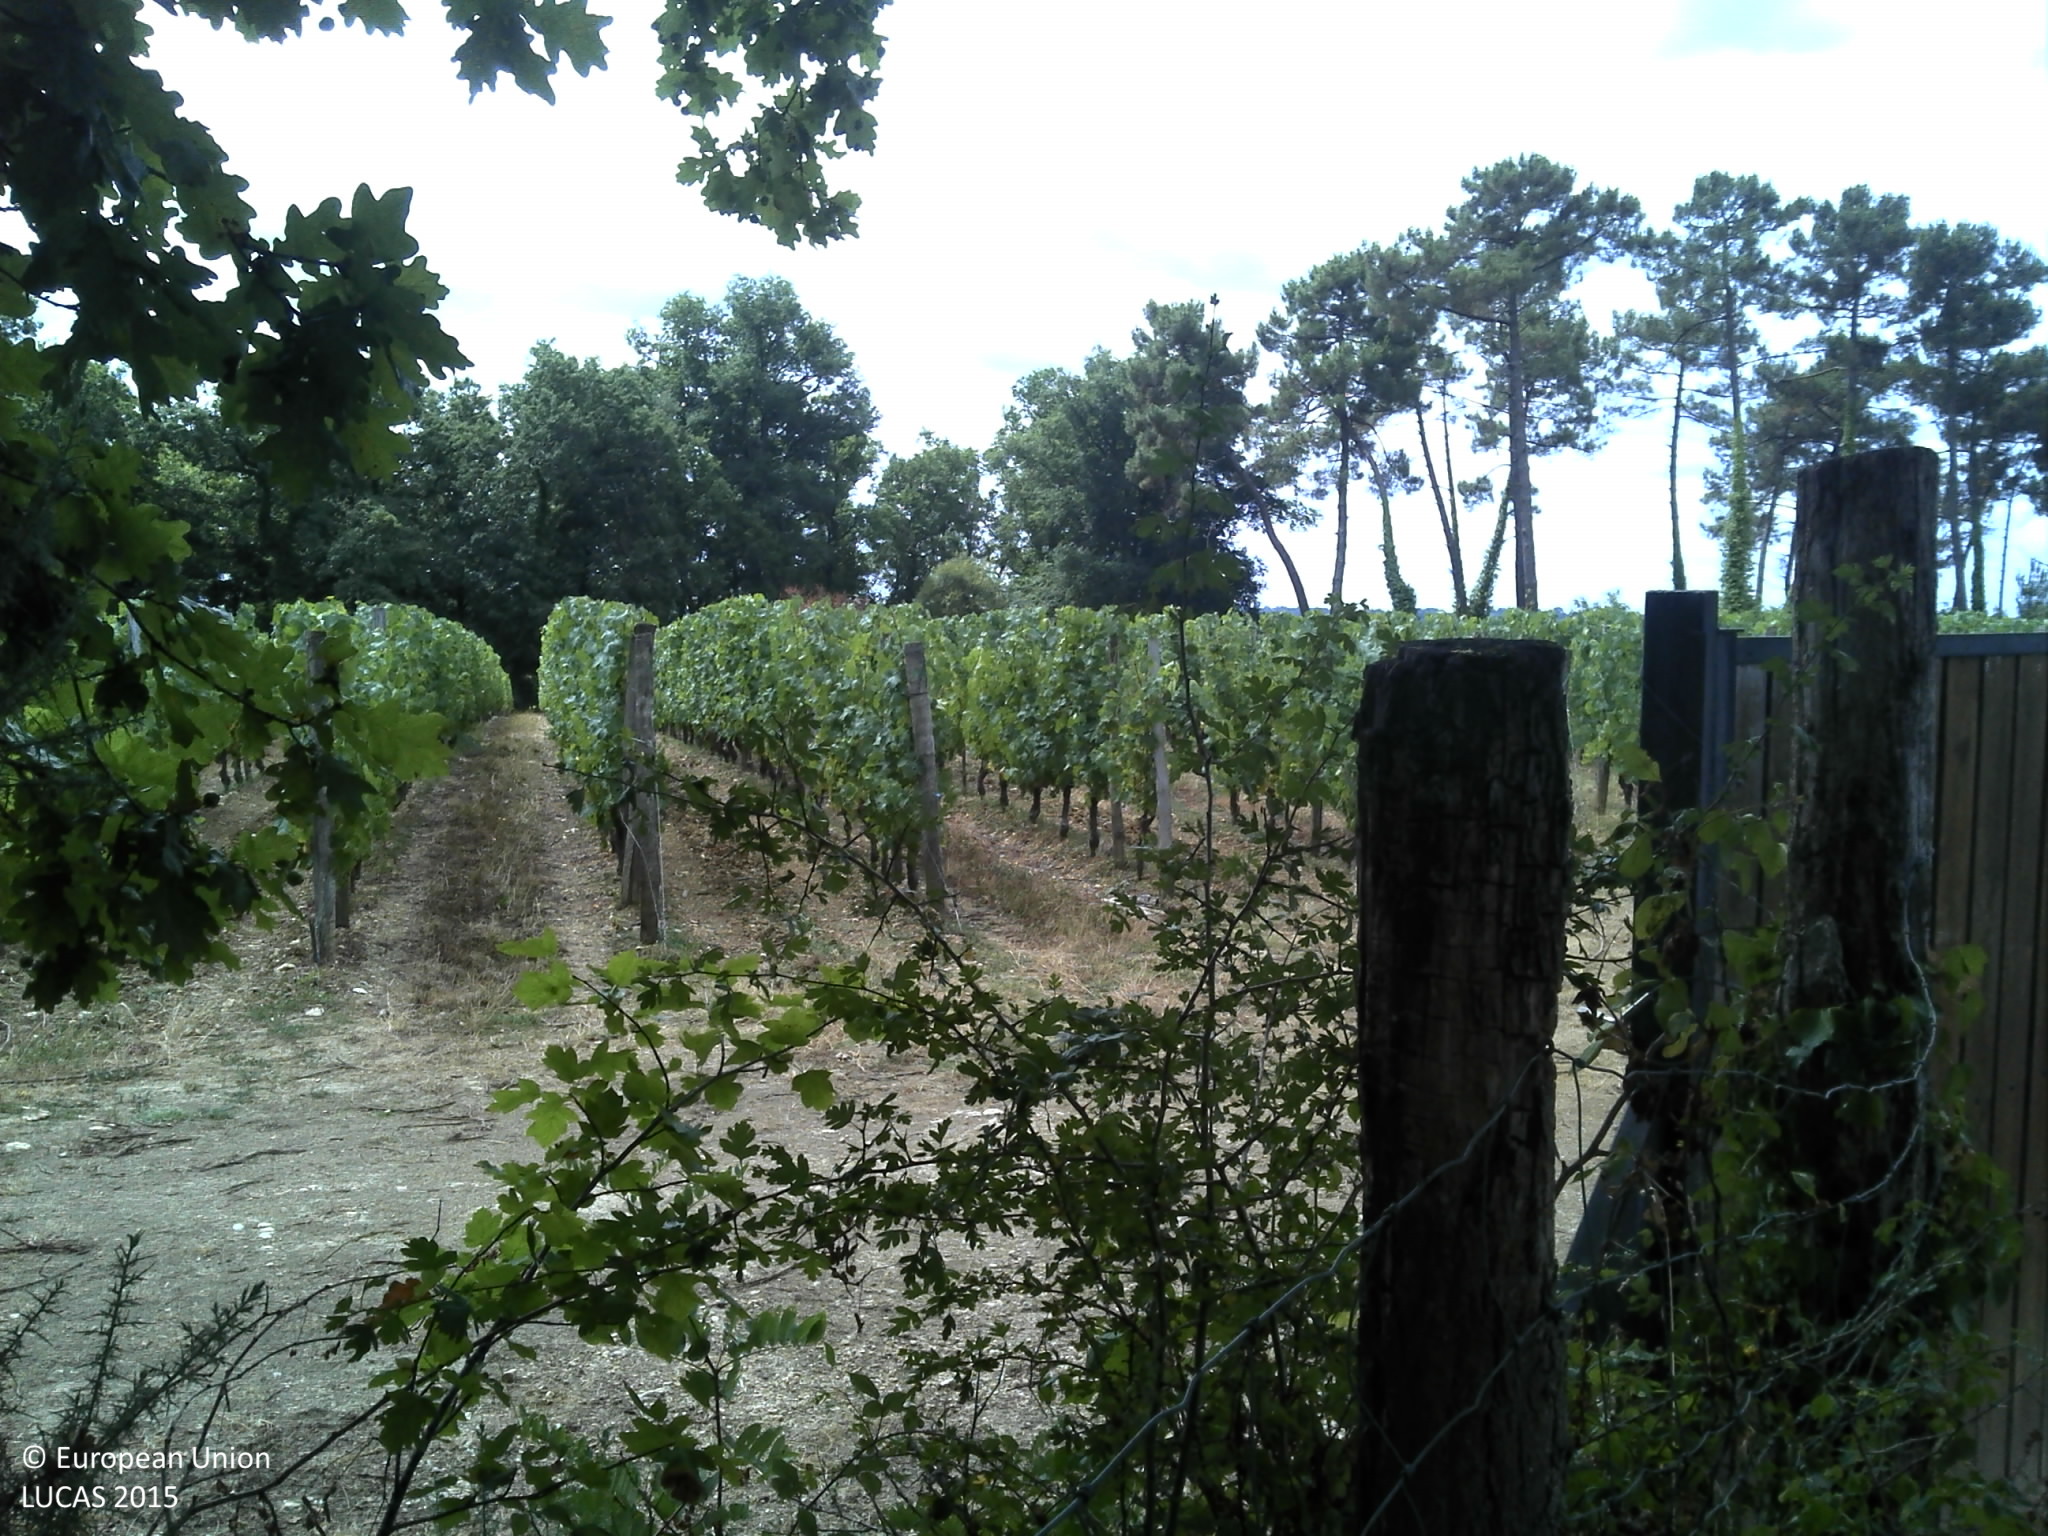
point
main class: Woodland
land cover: Broadleaved woodland
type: thermophilous deciduous forest
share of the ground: > 75 %
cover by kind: broadleaved forest trees 100 %
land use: Forestry
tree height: > 5 m
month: July
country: FR
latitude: 44.8055
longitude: -0.4222
